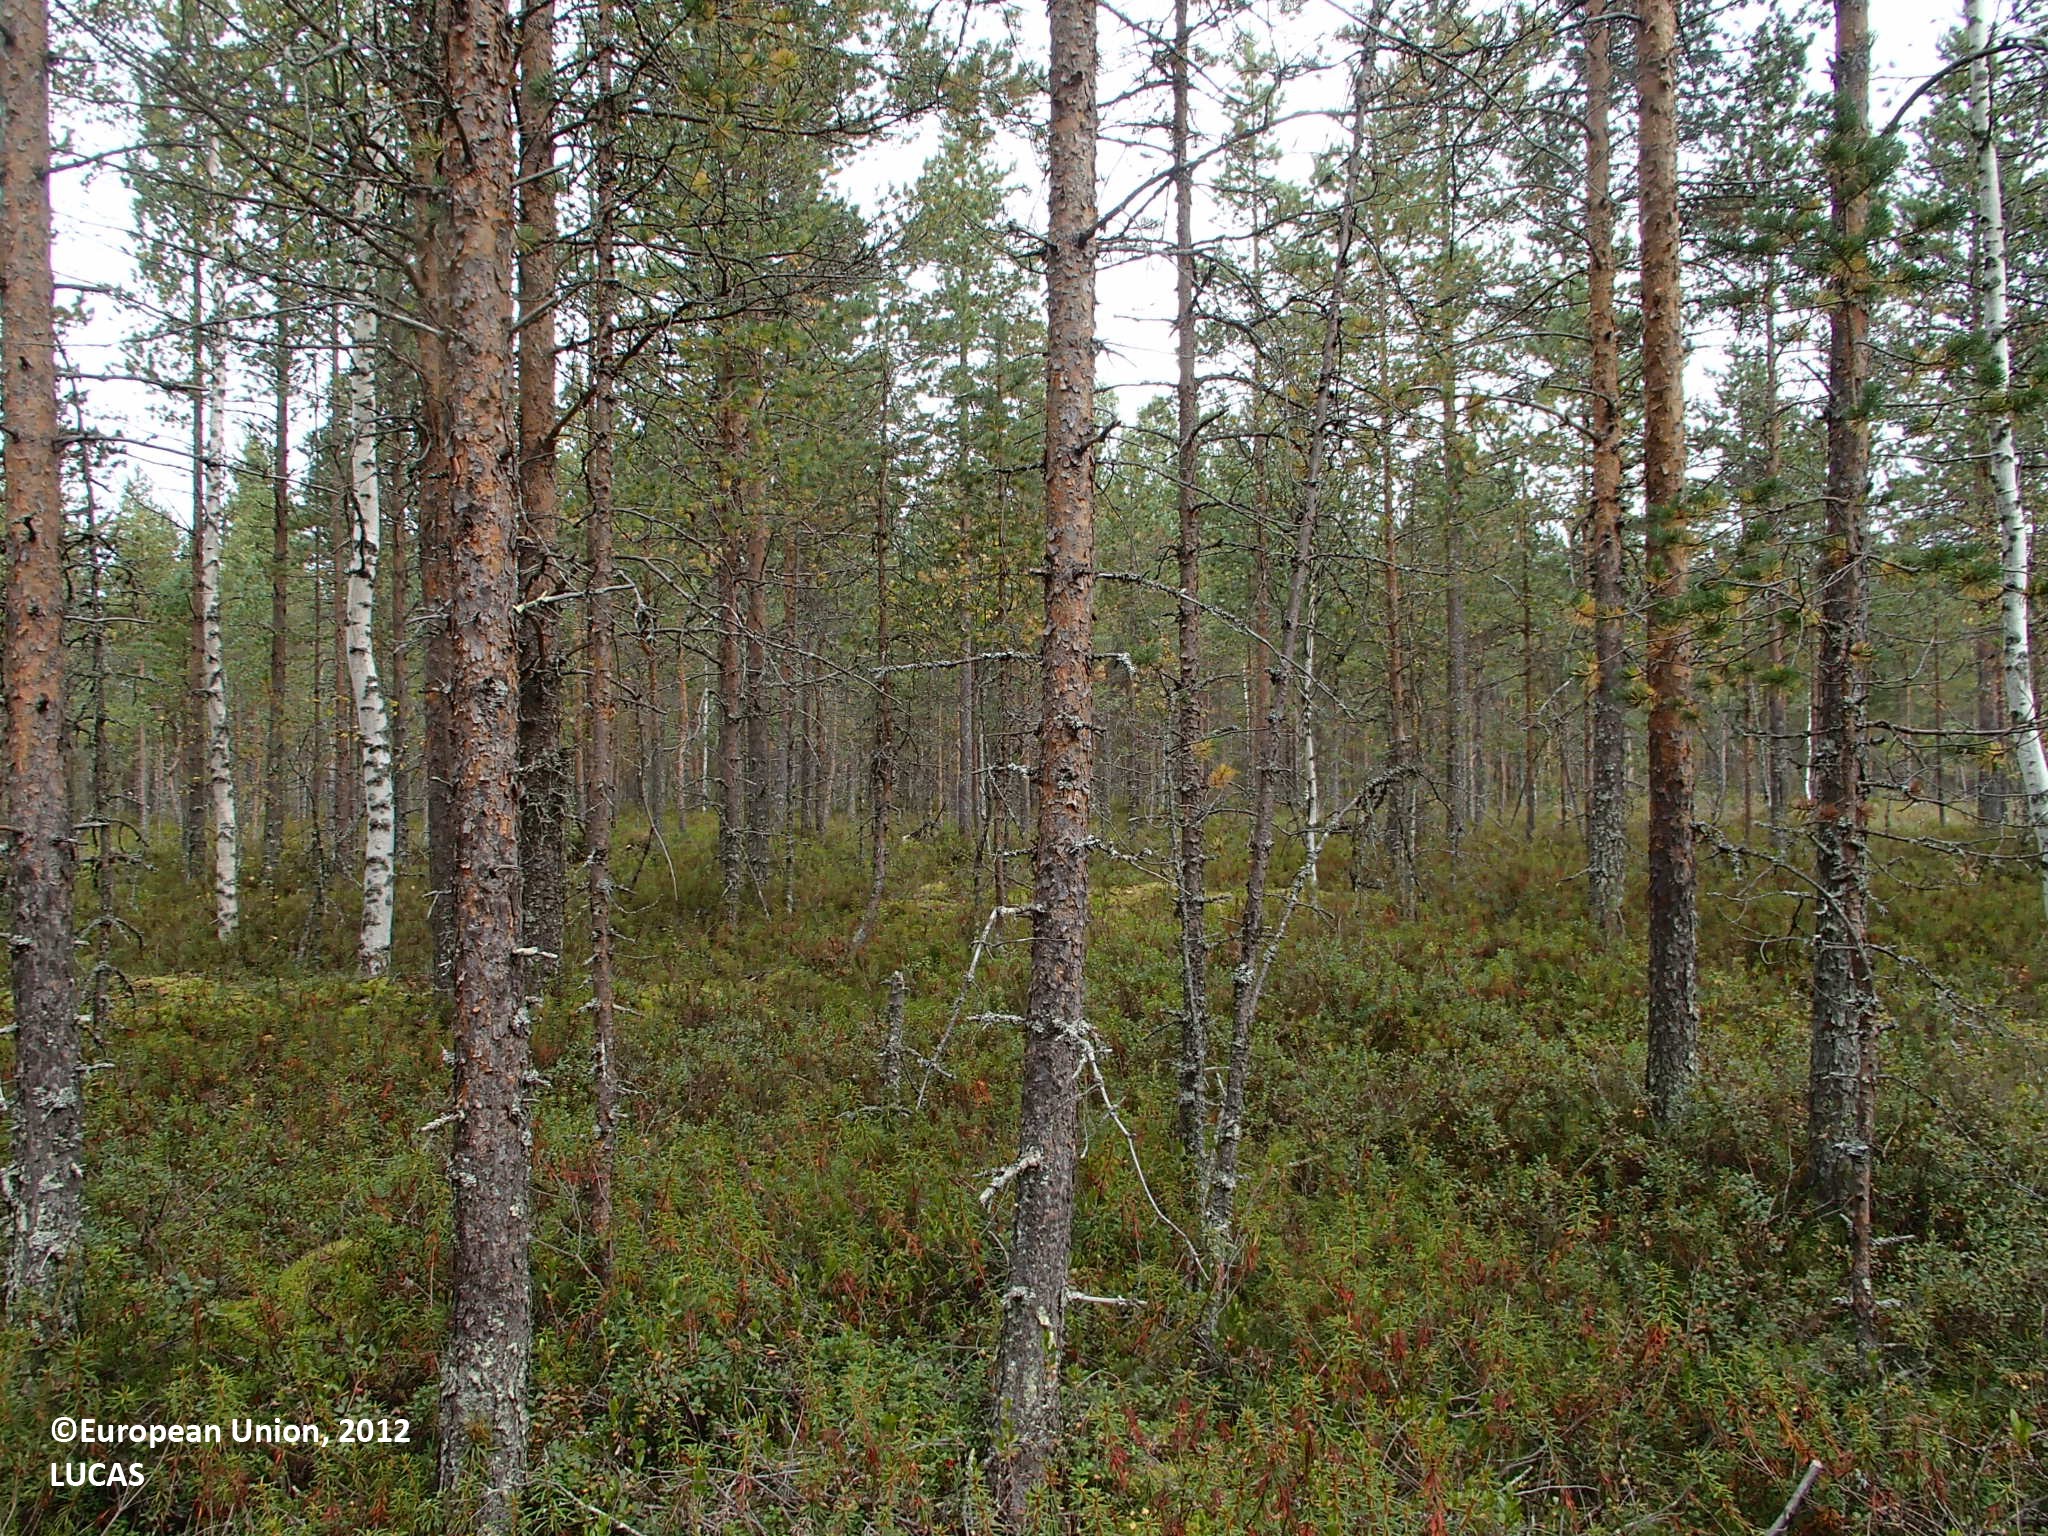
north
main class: Woodland
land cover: Pine dominated coniferous woodland
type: boreal forest
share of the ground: 50 - 75 %
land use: Forestry
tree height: > 5 m
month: September
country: FI
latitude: 63.7998
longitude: 26.0058
